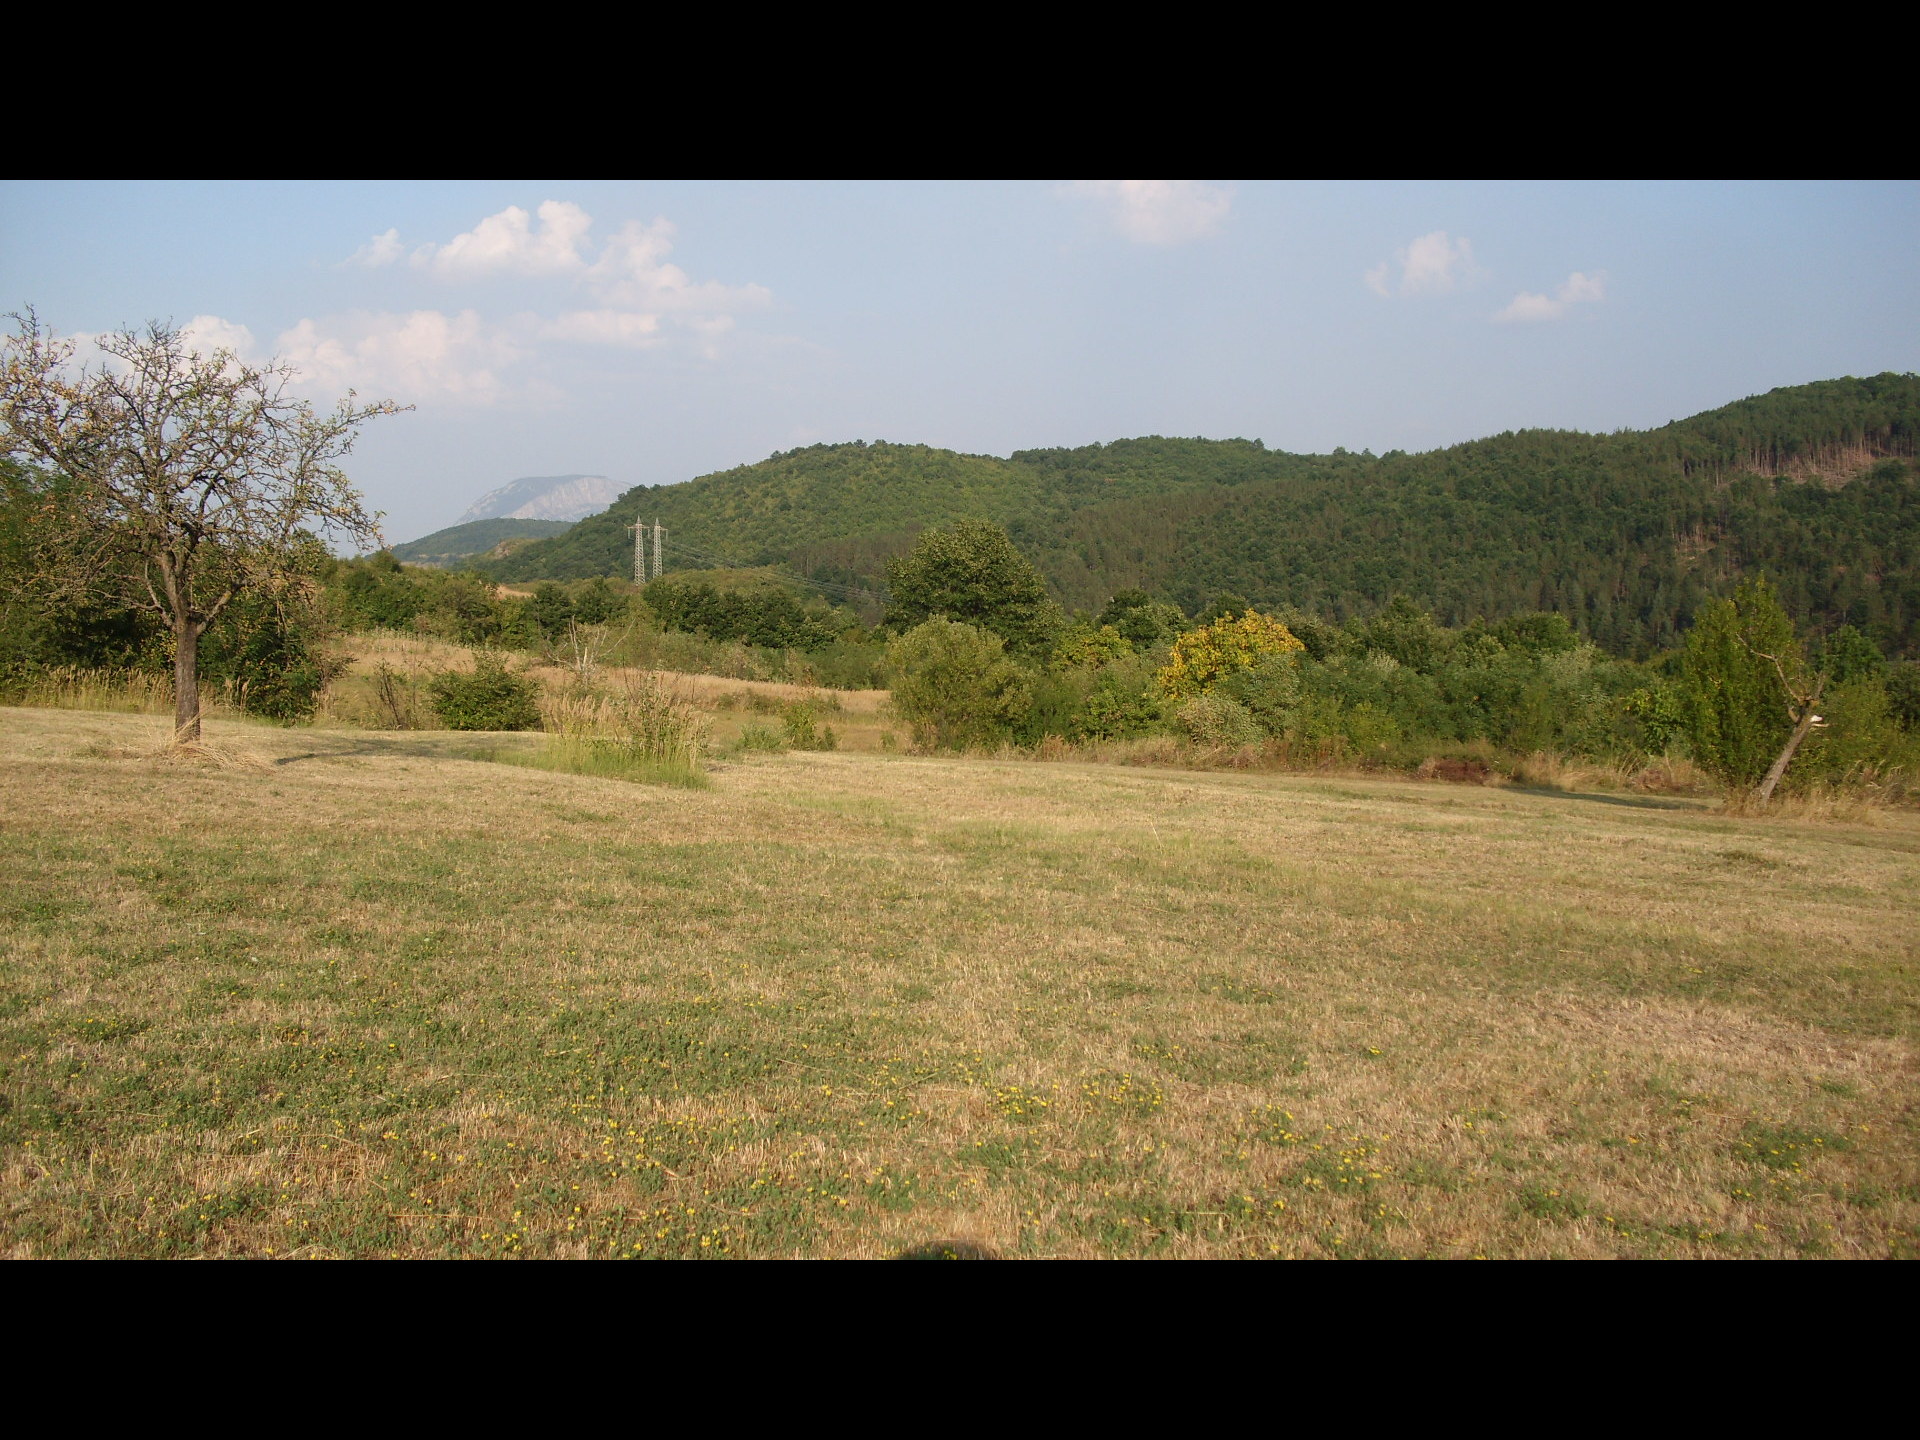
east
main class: Grassland
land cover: Grassland without tree/shrub cover
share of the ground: > 75 %
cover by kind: herbaceous plants 100 %
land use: Agriculture (excluding fallow land and kitchen gardens)
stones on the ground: < 10 %
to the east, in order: Grassland without tree/shrub cover; Grassland with sparse tree/shrub cover; Shrubland with sparse tree cover; Grassland without tree/shrub cover; Shrubland with sparse tree cover; Grassland without tree/shrub cover; Broadleaved woodland; Shrubland without tree cover; Broadleaved woodland
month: August
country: BG
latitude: 43.2406
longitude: 23.2524
